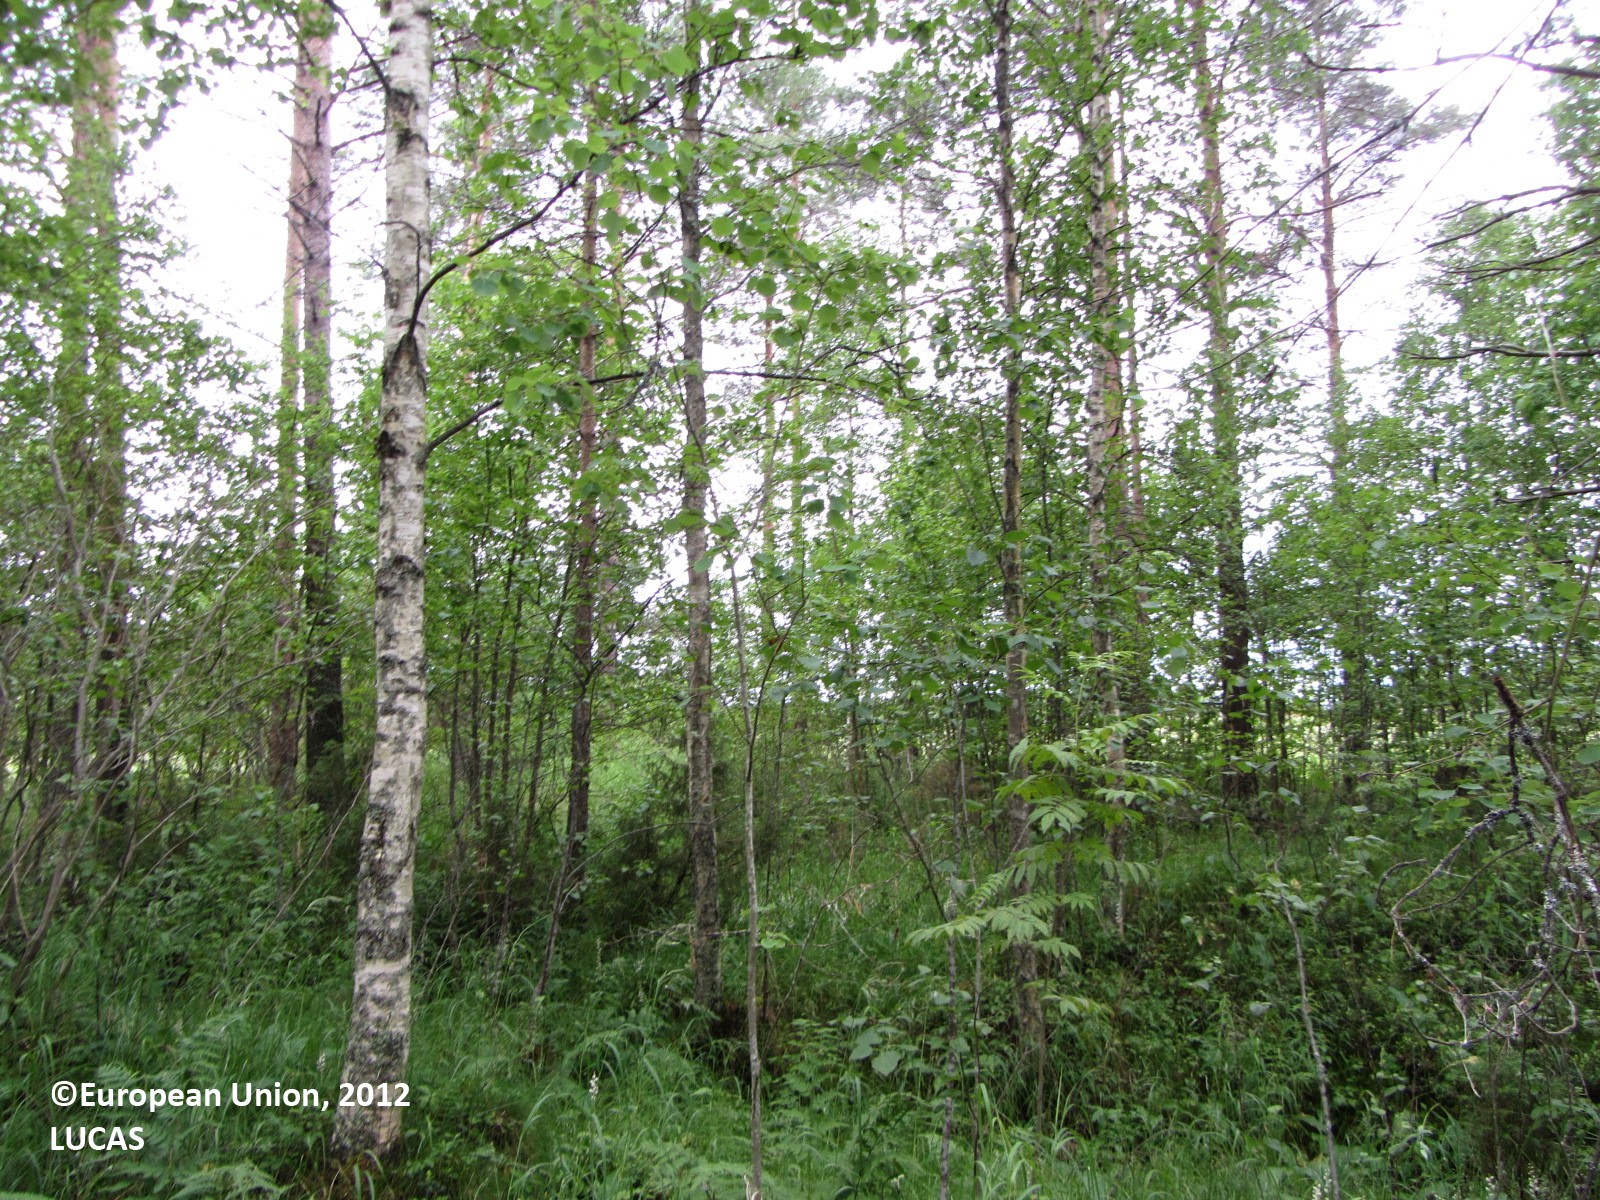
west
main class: Woodland
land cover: Pine dominated mixed woodland
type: boreal forest
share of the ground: > 75 %
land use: Forestry
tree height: > 5 m
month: July
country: FI
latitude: 63.7391
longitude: 25.5149
